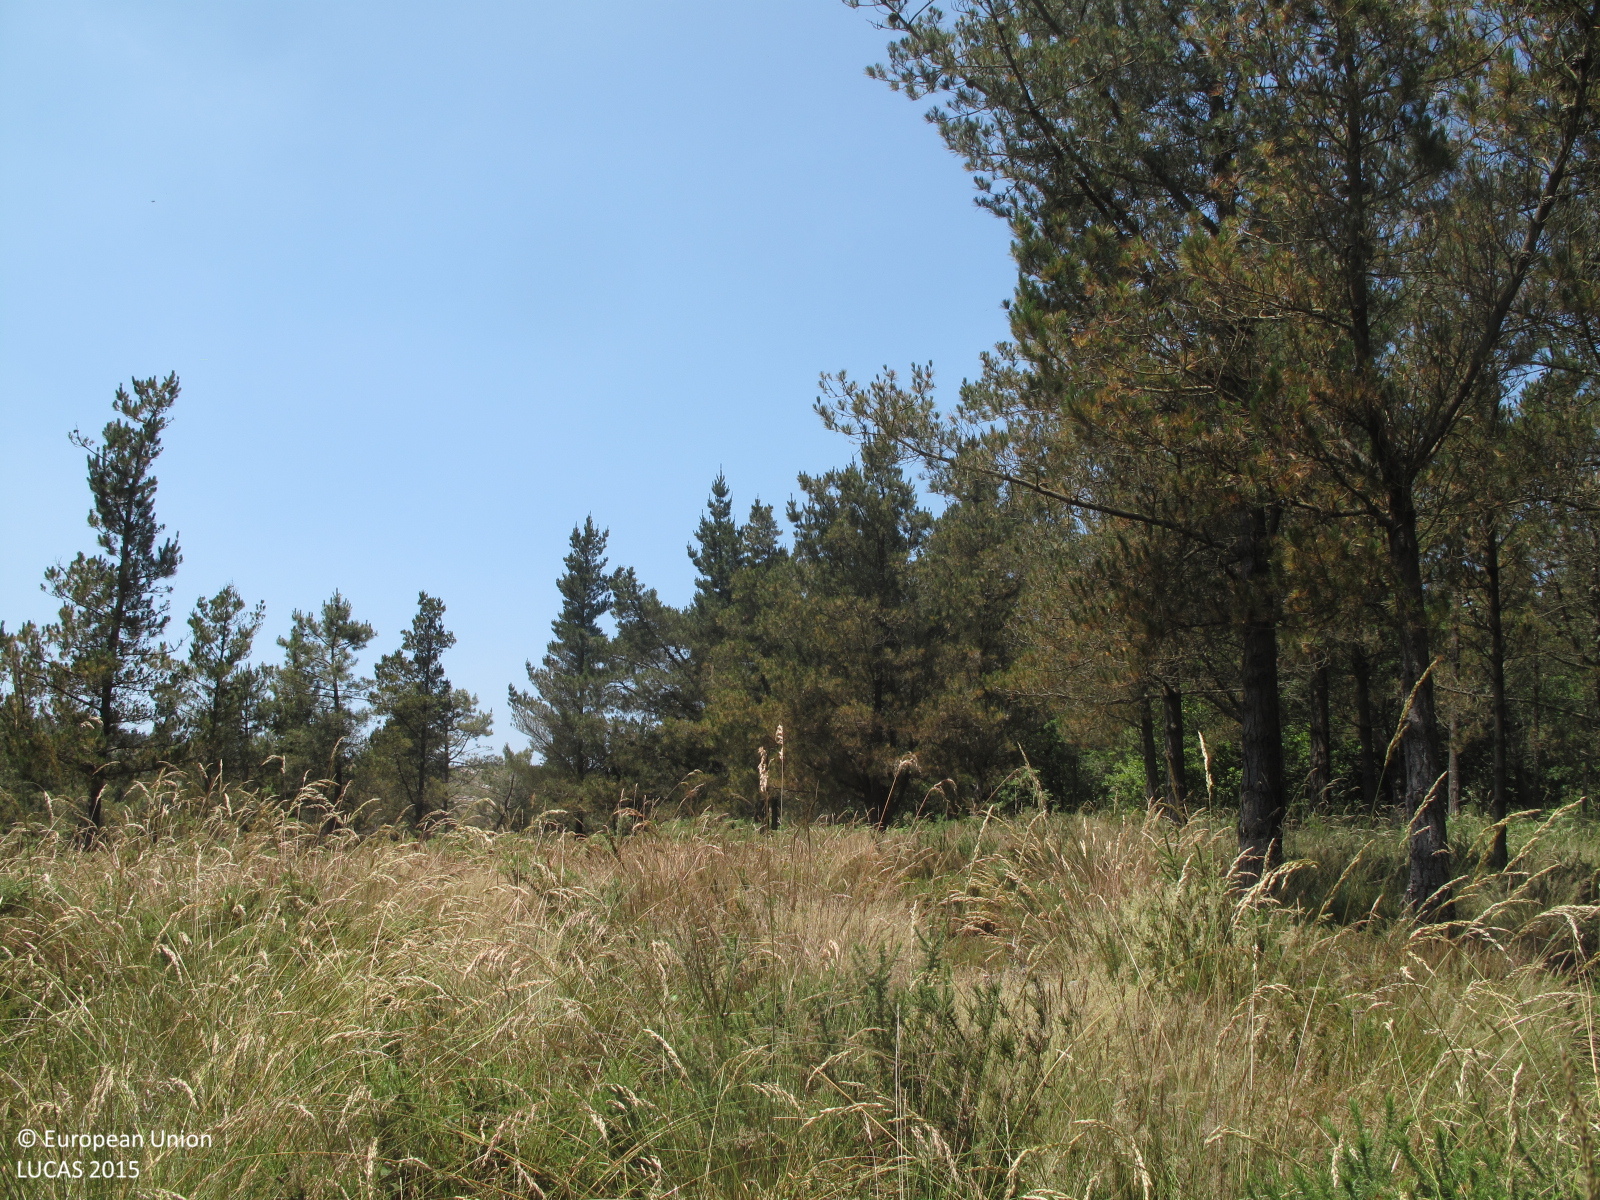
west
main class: Woodland
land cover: Pine dominated coniferous woodland
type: exotic forest
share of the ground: 25 - 50 %
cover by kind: herbaceous plants 40 %, coniferous forest trees 30 %, shrubs 30 %
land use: Forestry
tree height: > 5 m
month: June
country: ES
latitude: 43.2554
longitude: -7.9145
